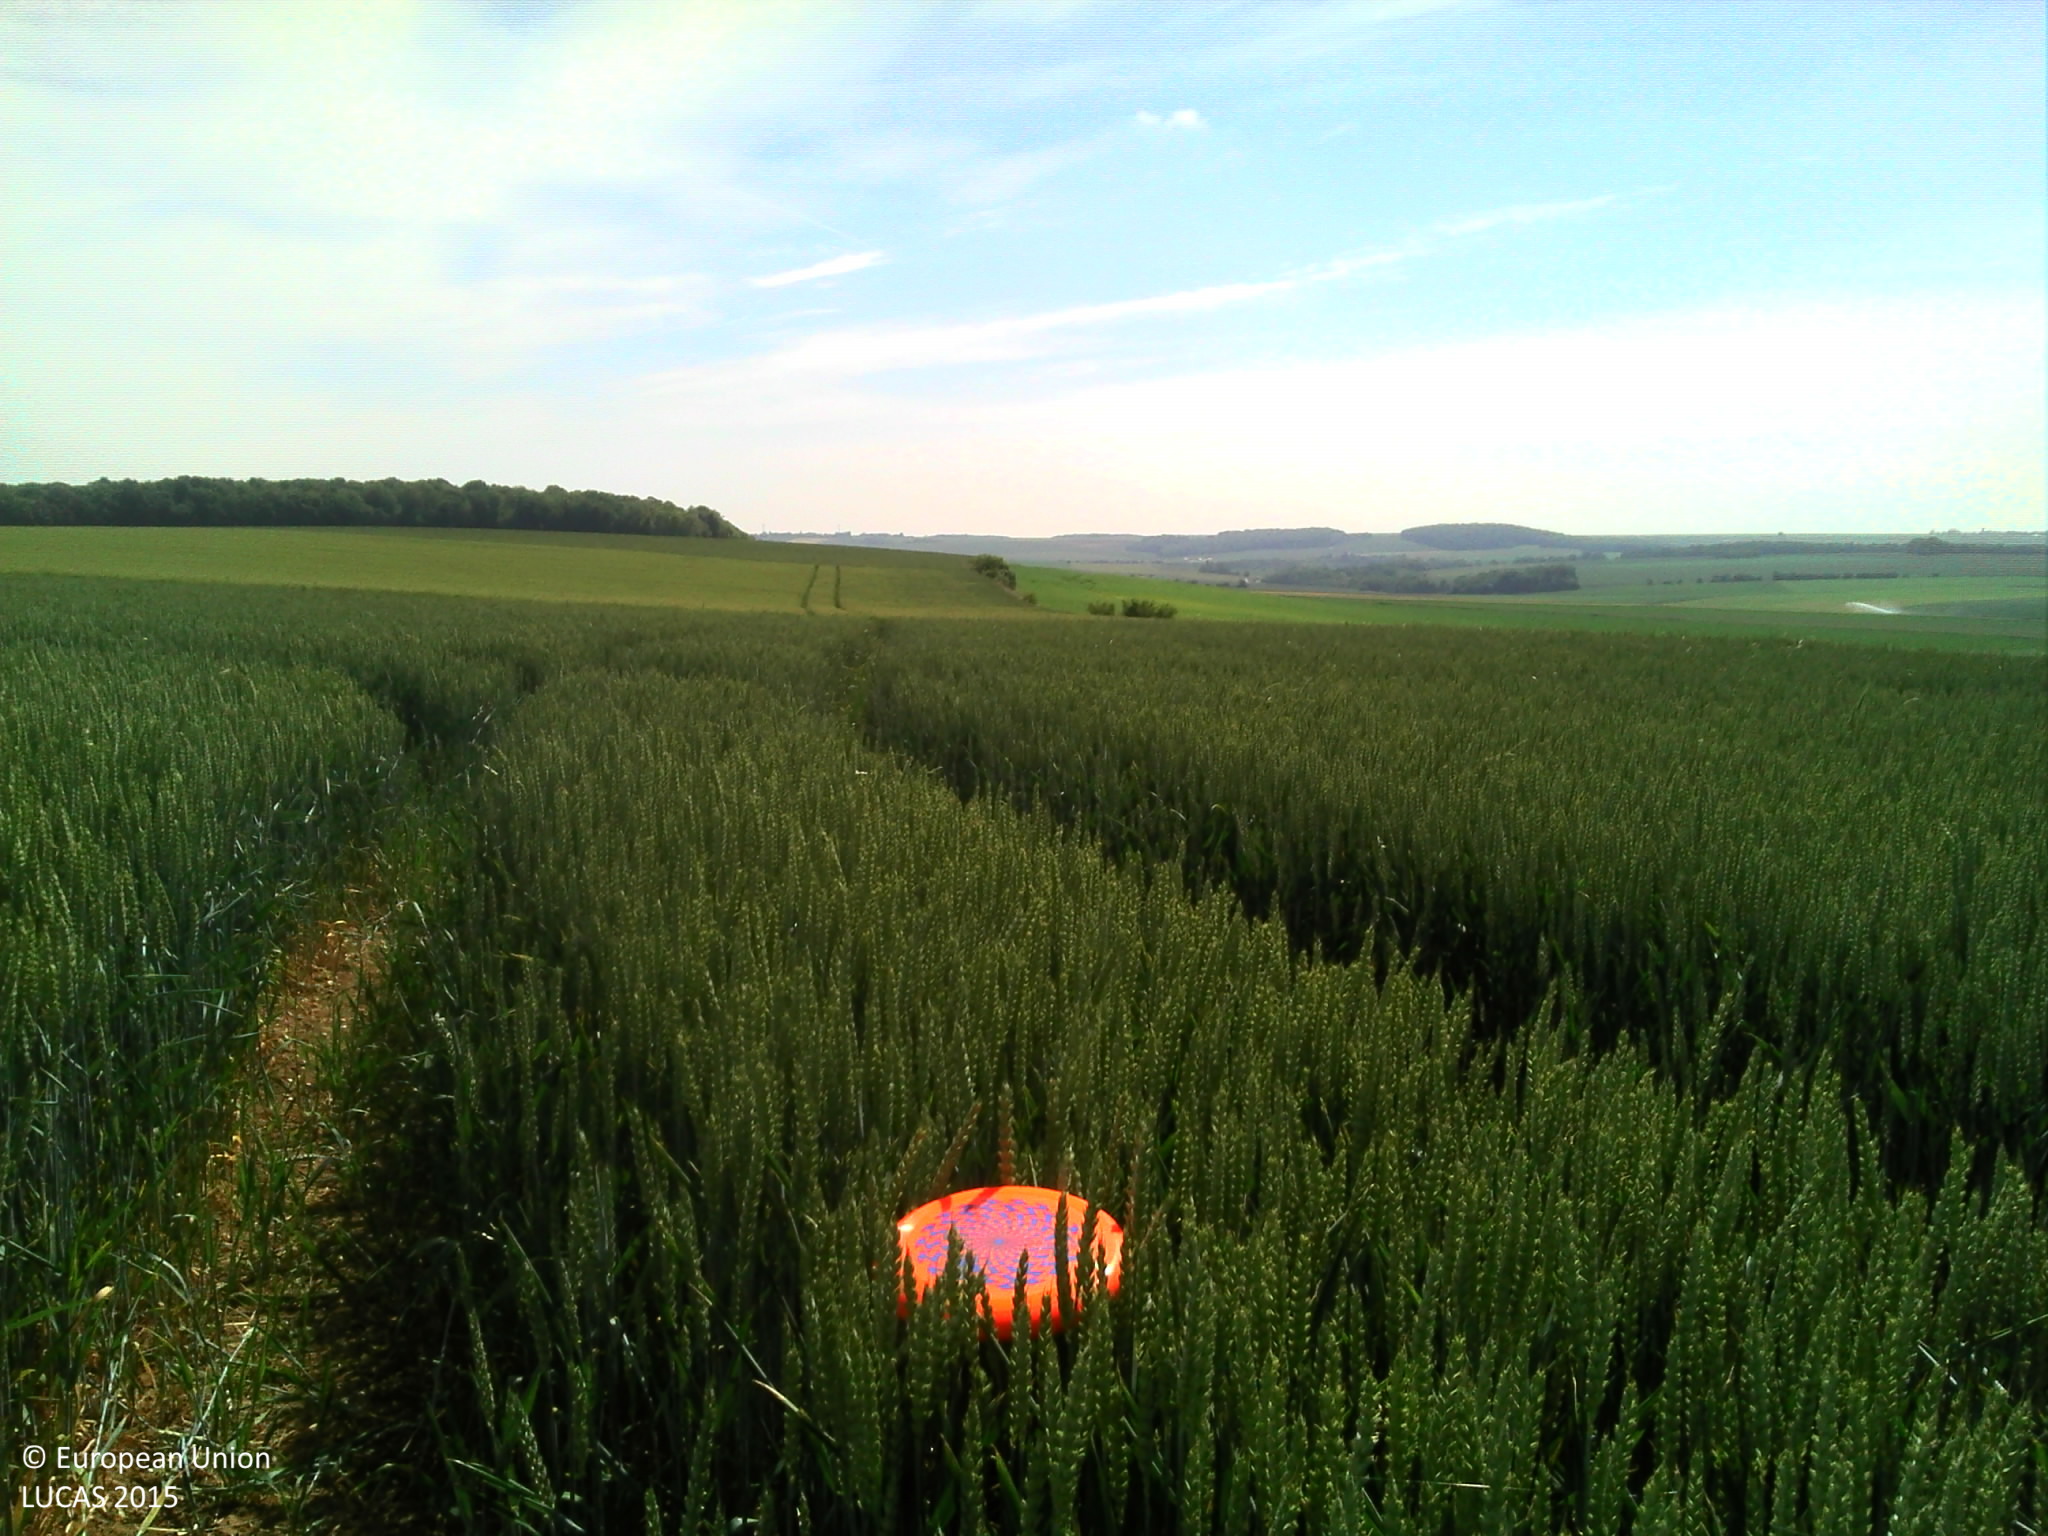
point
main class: Cropland
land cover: Common wheat
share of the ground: > 75 %
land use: Agriculture (excluding fallow land and kitchen gardens)
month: June
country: FR
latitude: 49.7062
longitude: 2.2907
